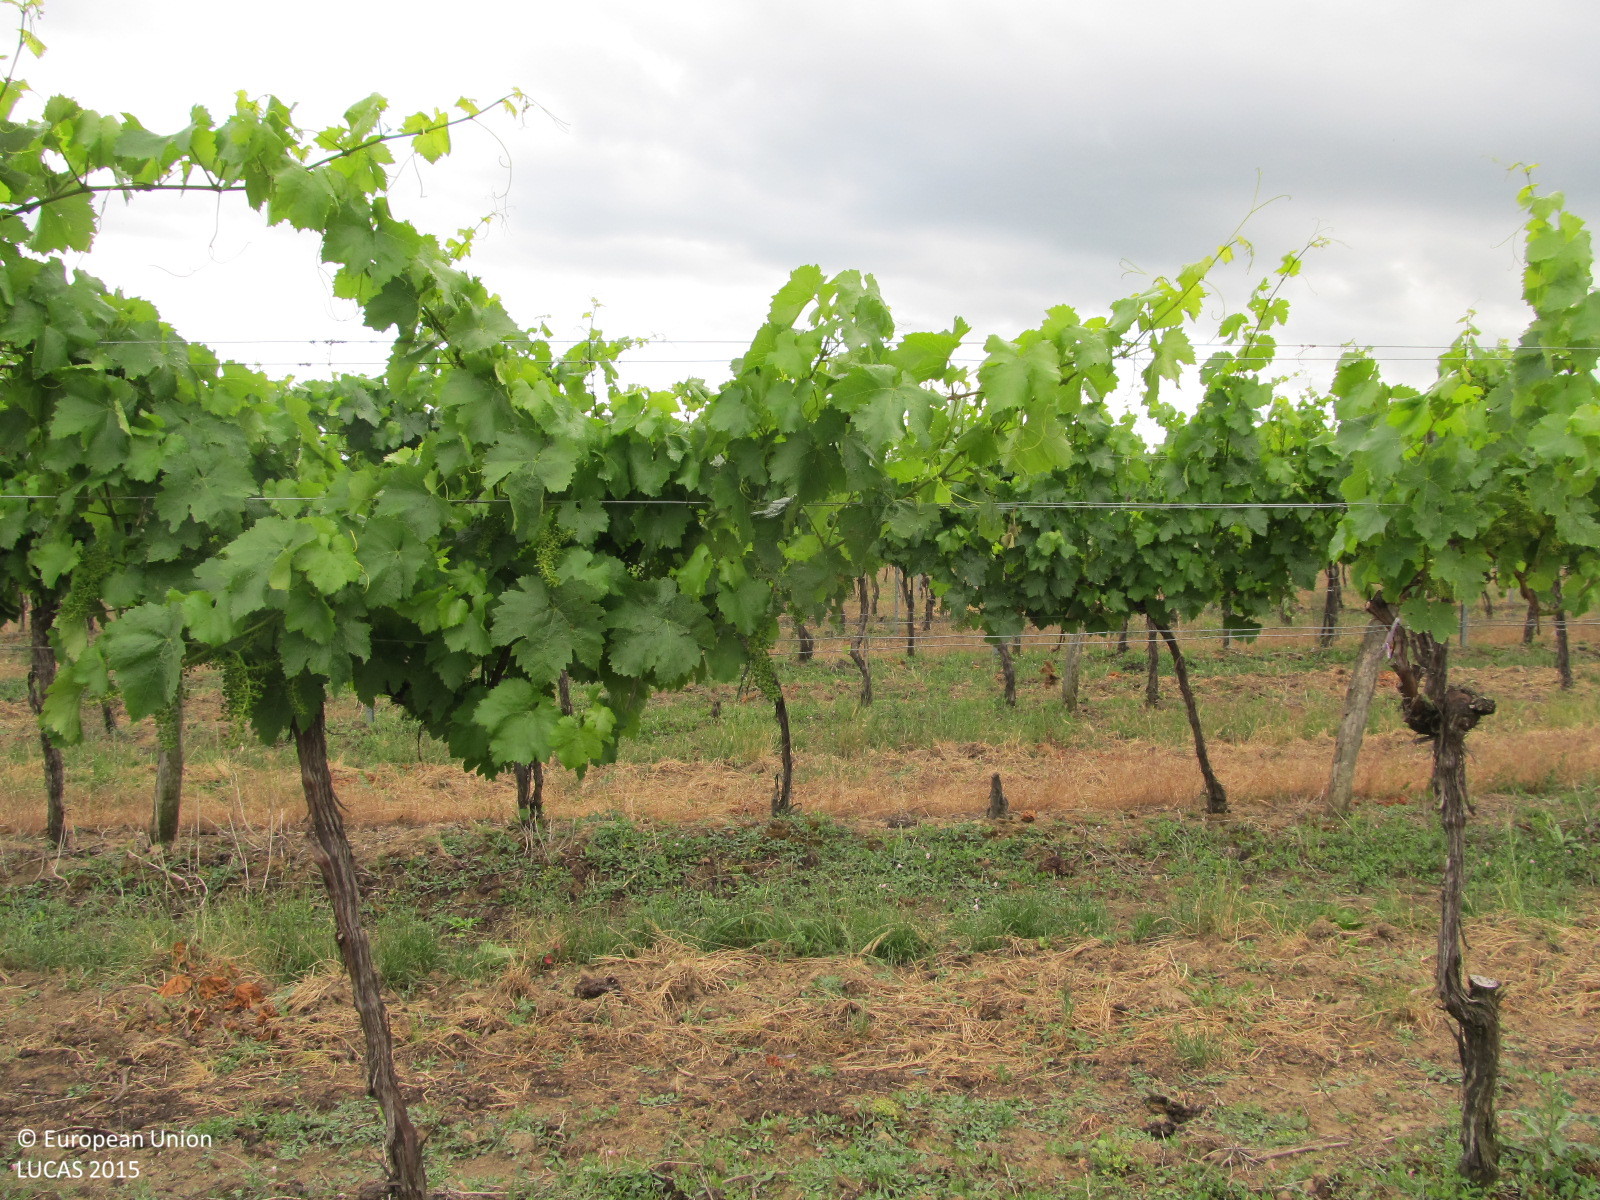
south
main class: Cropland
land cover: Vineyards
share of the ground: 25 - 50 %
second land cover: Grassland without tree/shrub cover
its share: 50 - 75 %
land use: Agriculture (excluding fallow land and kitchen gardens)
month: June
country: AT
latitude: 48.7218
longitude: 16.1082
